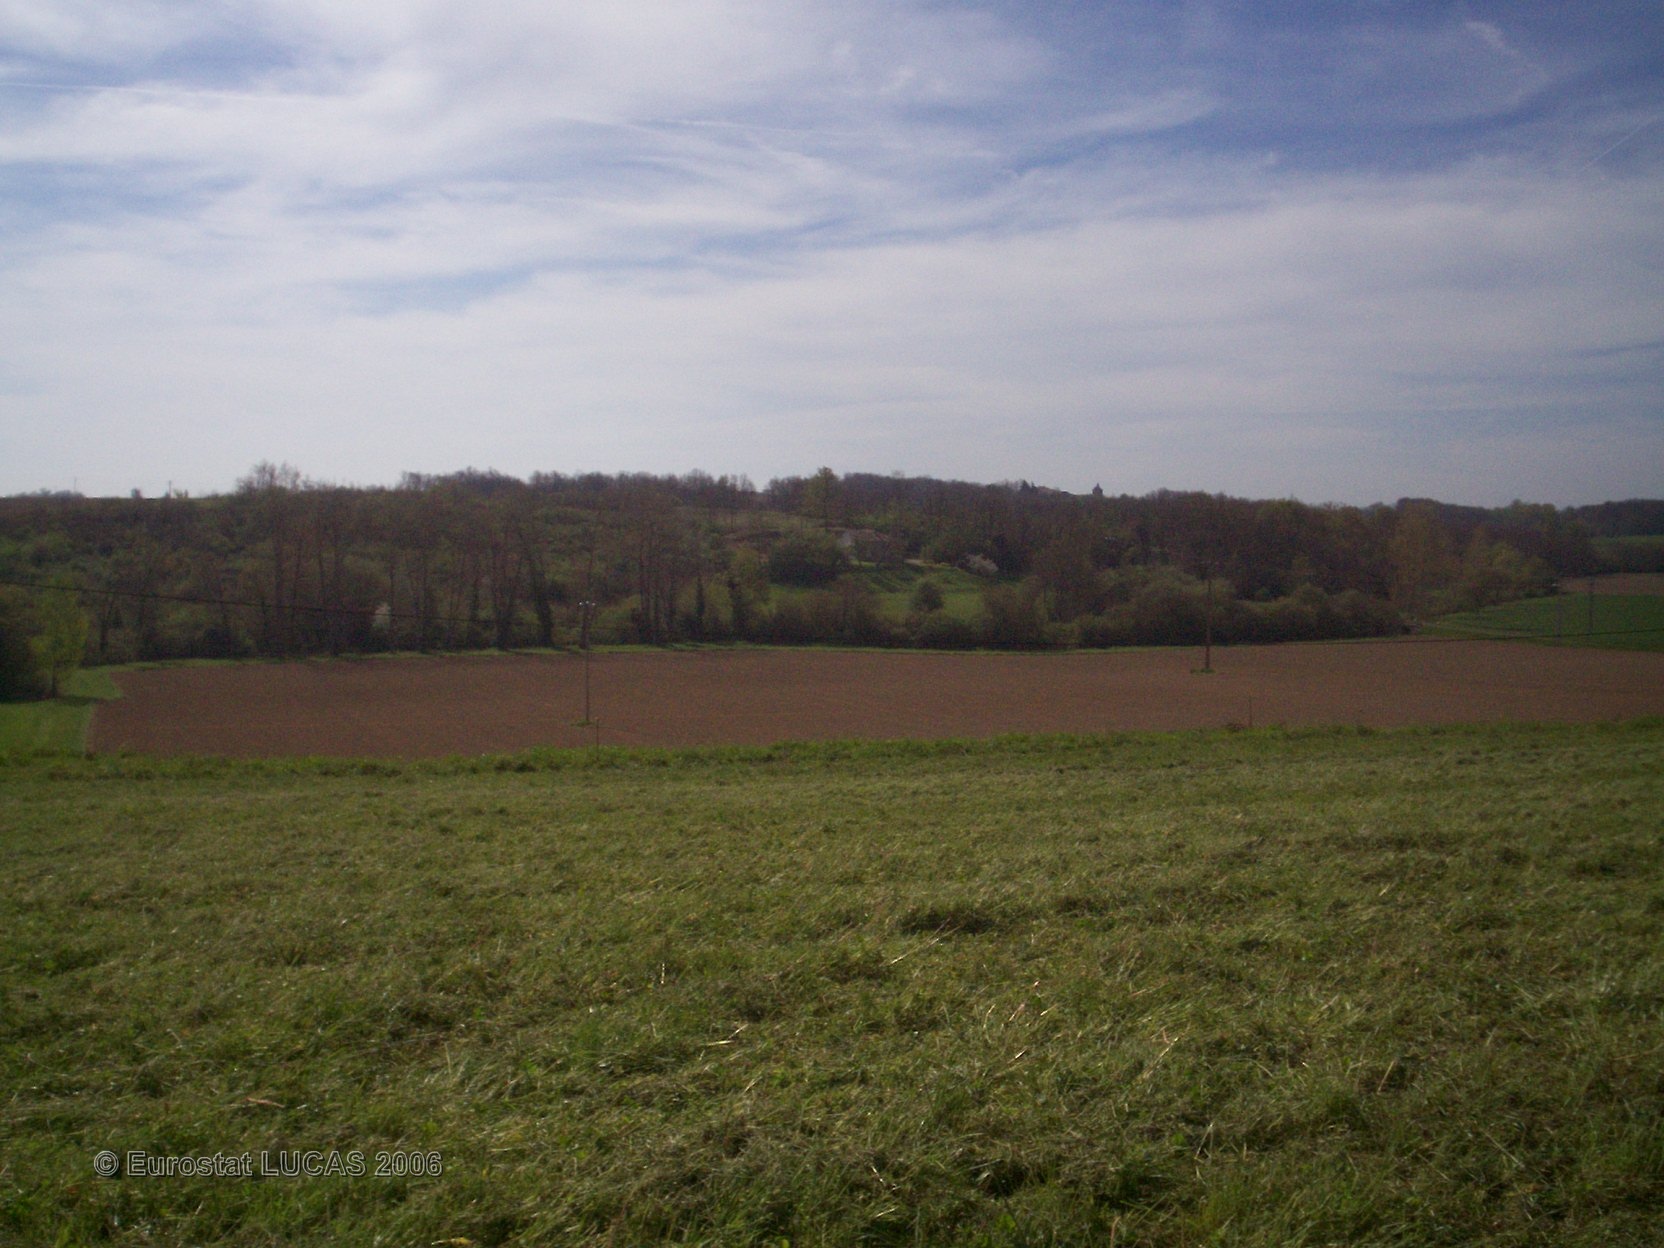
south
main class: Grassland
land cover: Grassland without tree/shrub cover
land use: Agriculture (excluding fallow land and kitchen gardens)
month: April
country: FR
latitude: 44.0115
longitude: 0.9798
